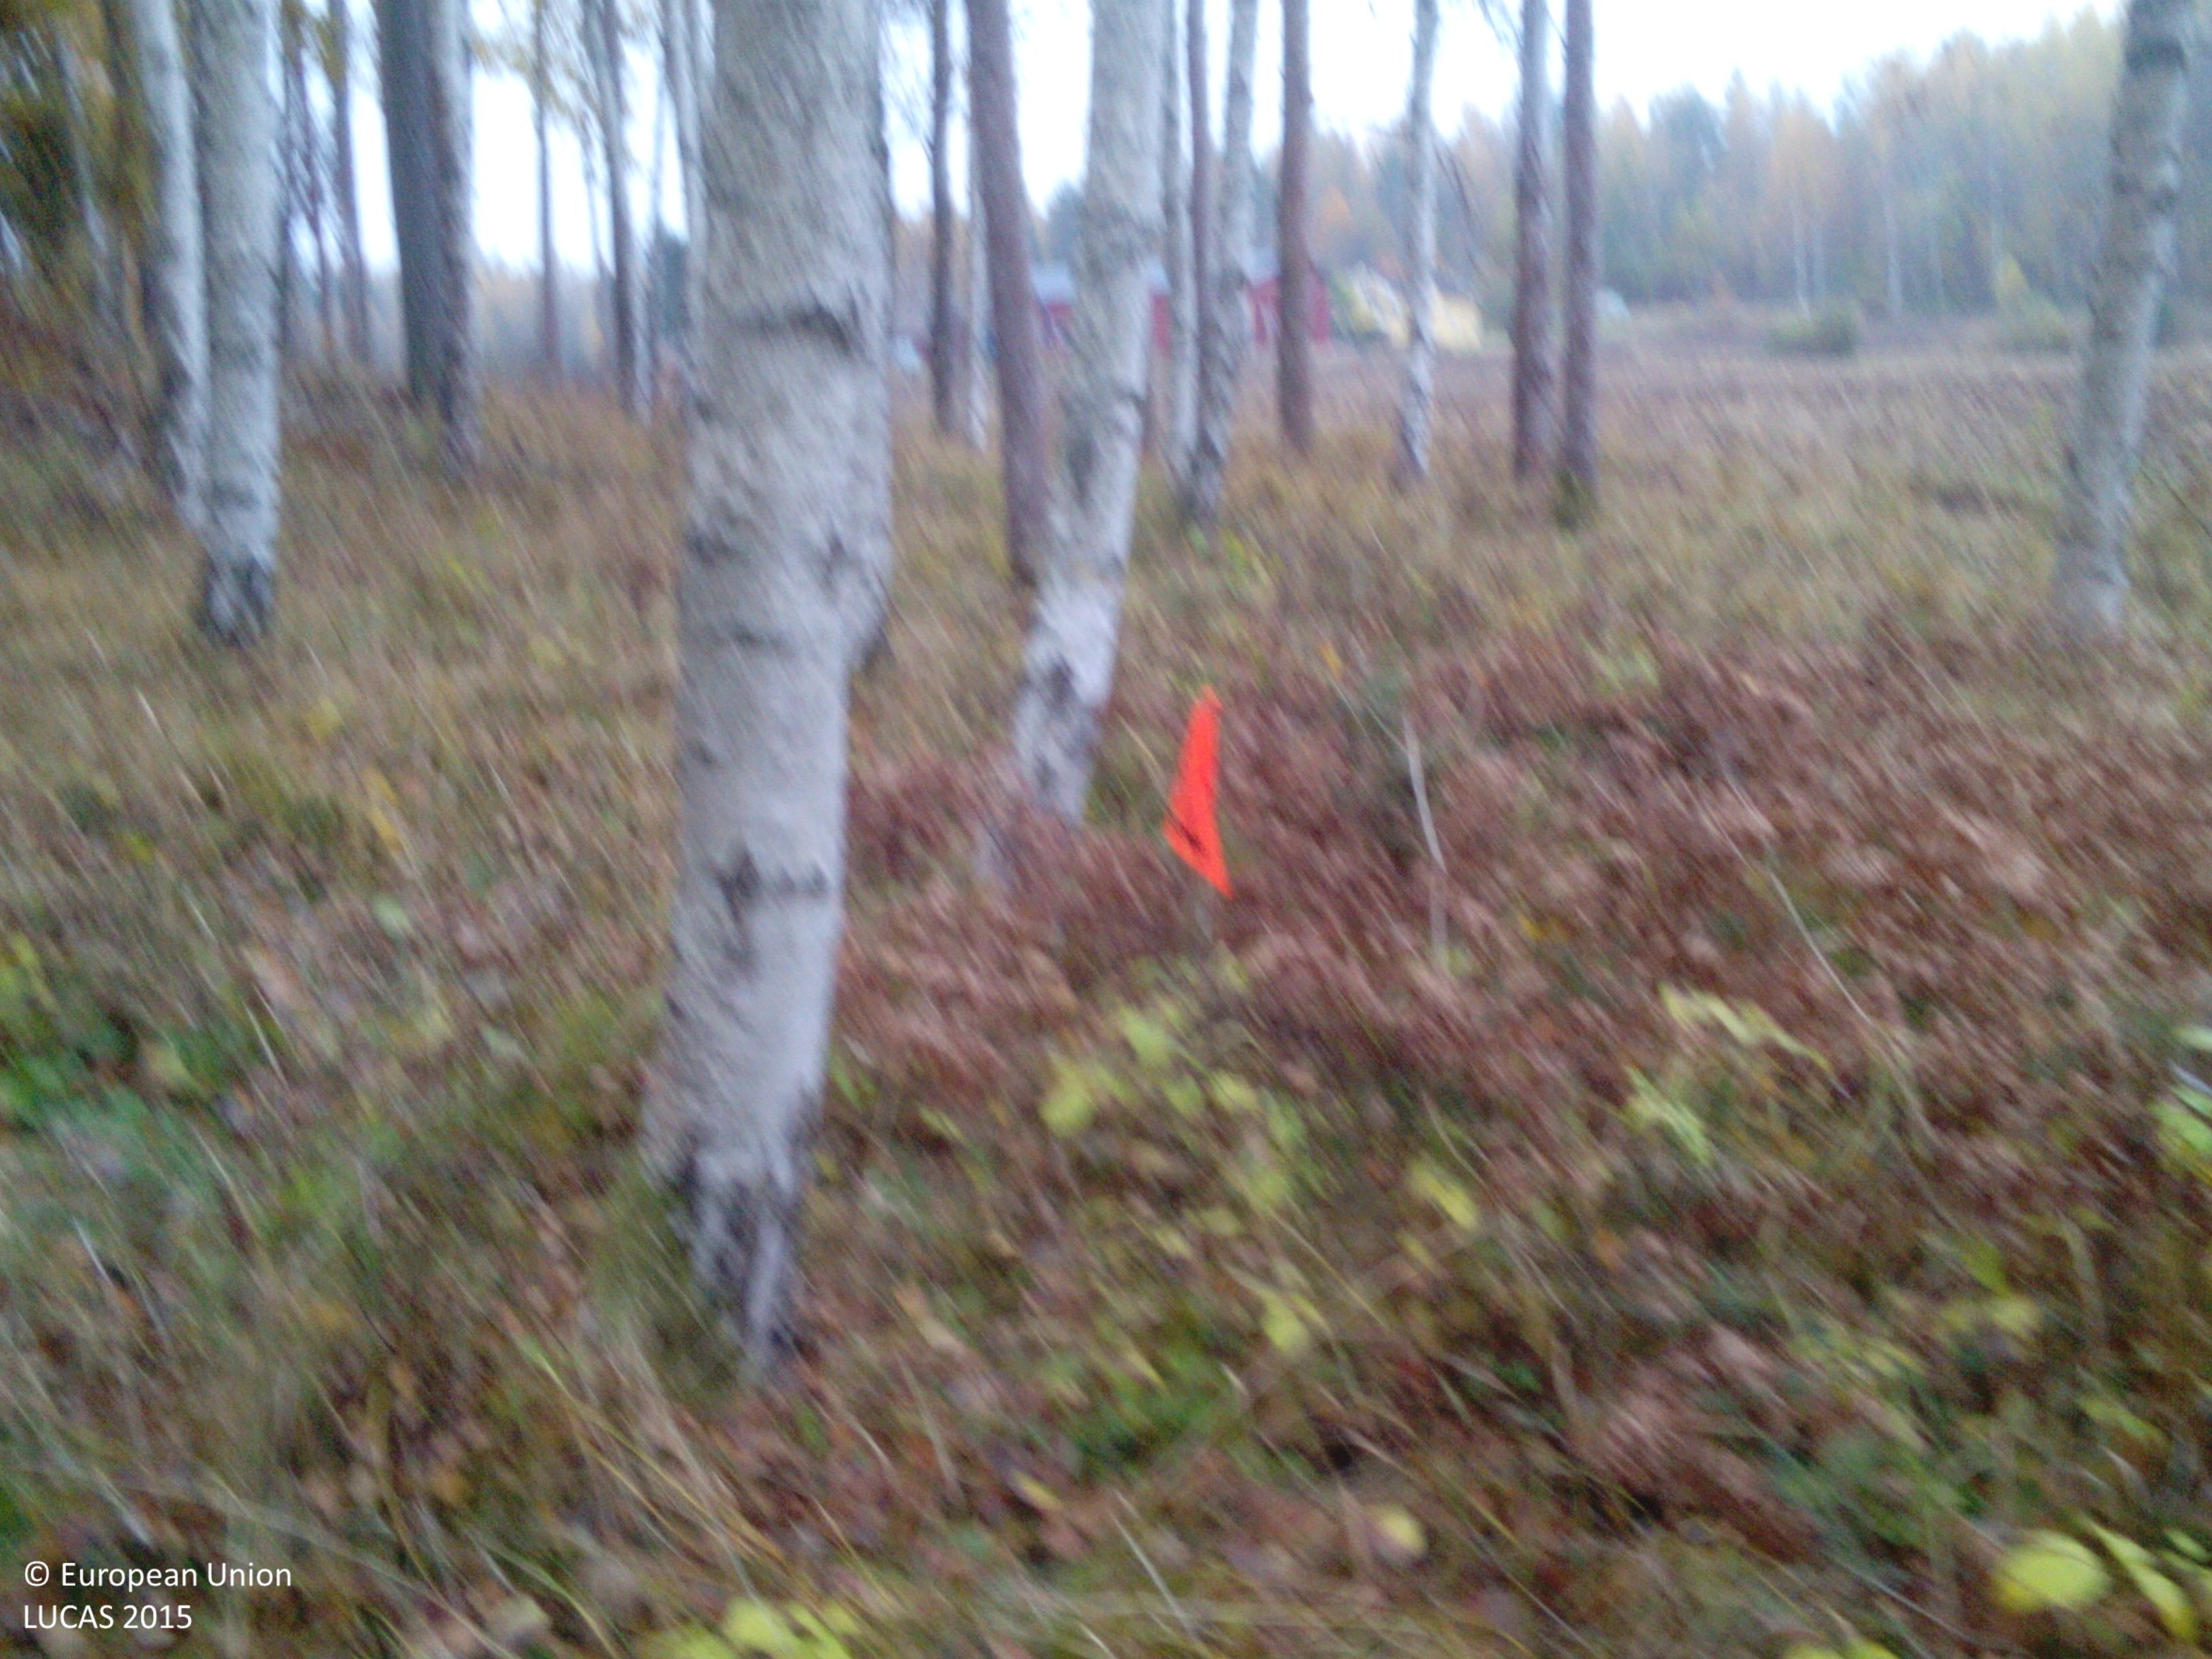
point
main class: Woodland
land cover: Broadleaved woodland
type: hemiboreal forest and nemoral coniferous forest and mixed broadleaved-coniferous forest
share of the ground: > 75 %
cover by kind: broadleaved forest trees 80 %, herbaceous plants 20 %
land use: Forestry
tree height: > 5 m
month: October
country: SE
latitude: 59.0862
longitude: 16.2235
